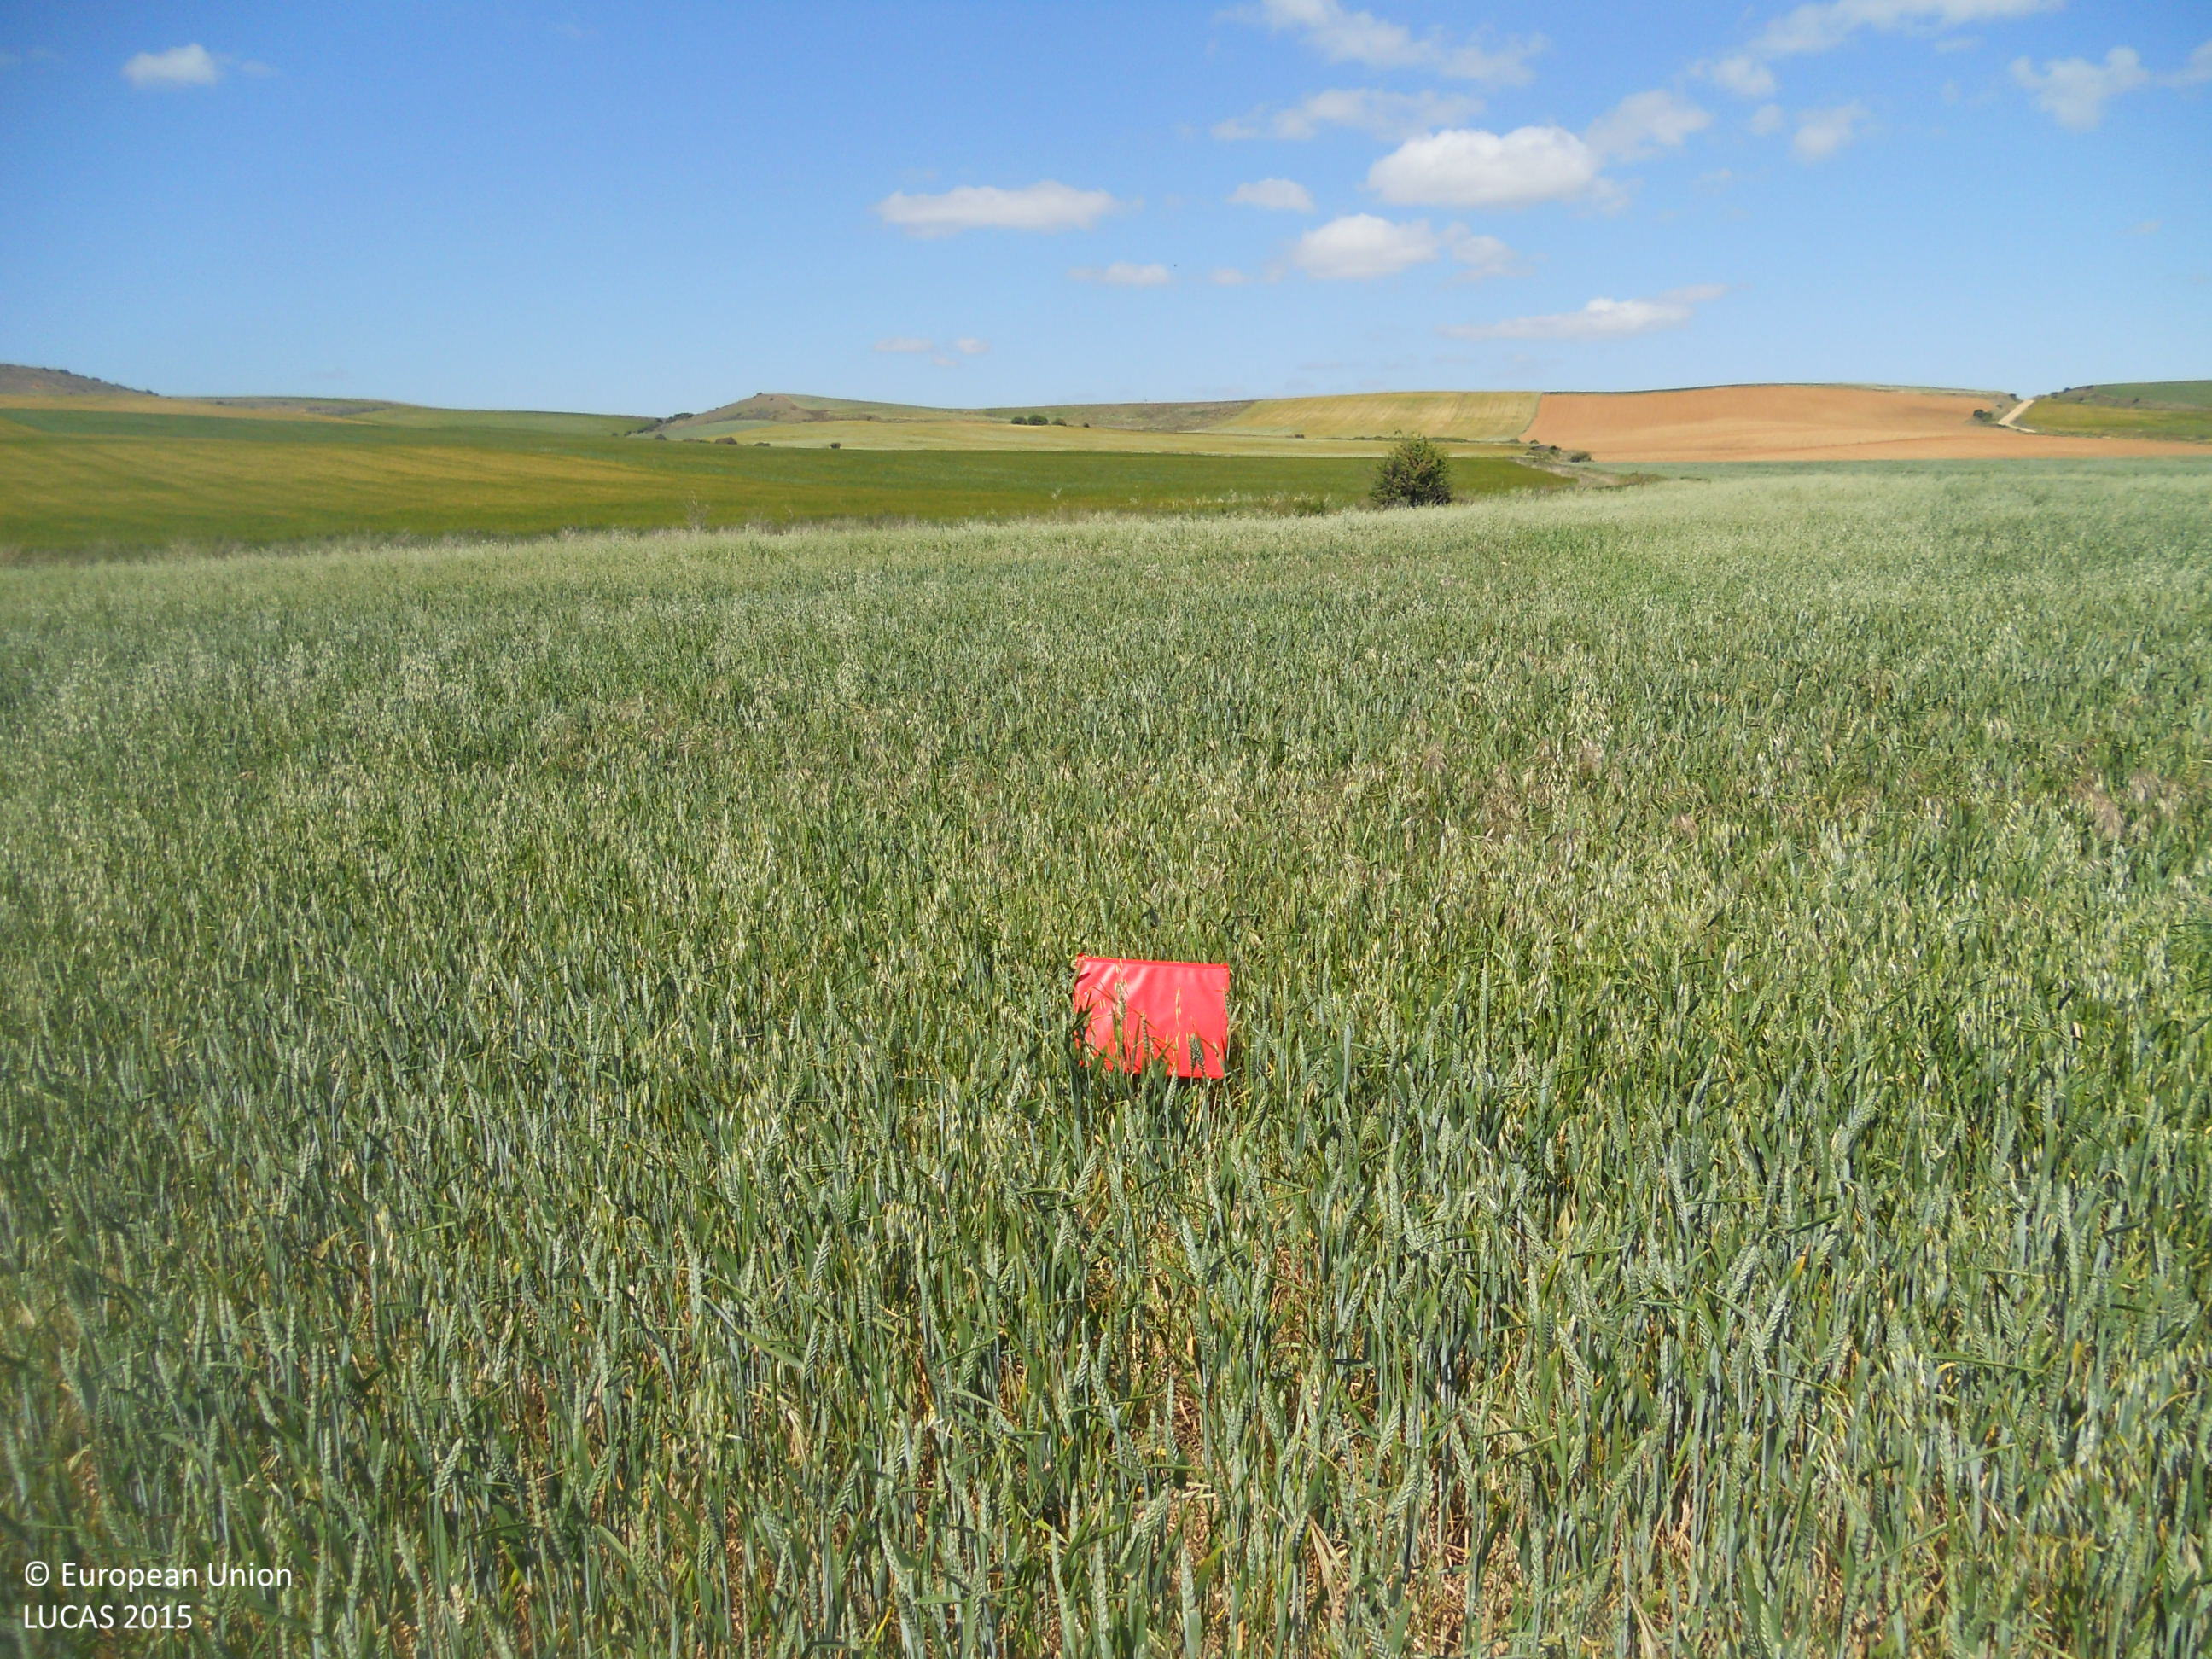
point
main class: Cropland
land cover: Common wheat
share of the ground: > 75 %
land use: Agriculture (excluding fallow land and kitchen gardens)
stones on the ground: < 10 %
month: May
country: ES
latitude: 42.3639
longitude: -4.3134
